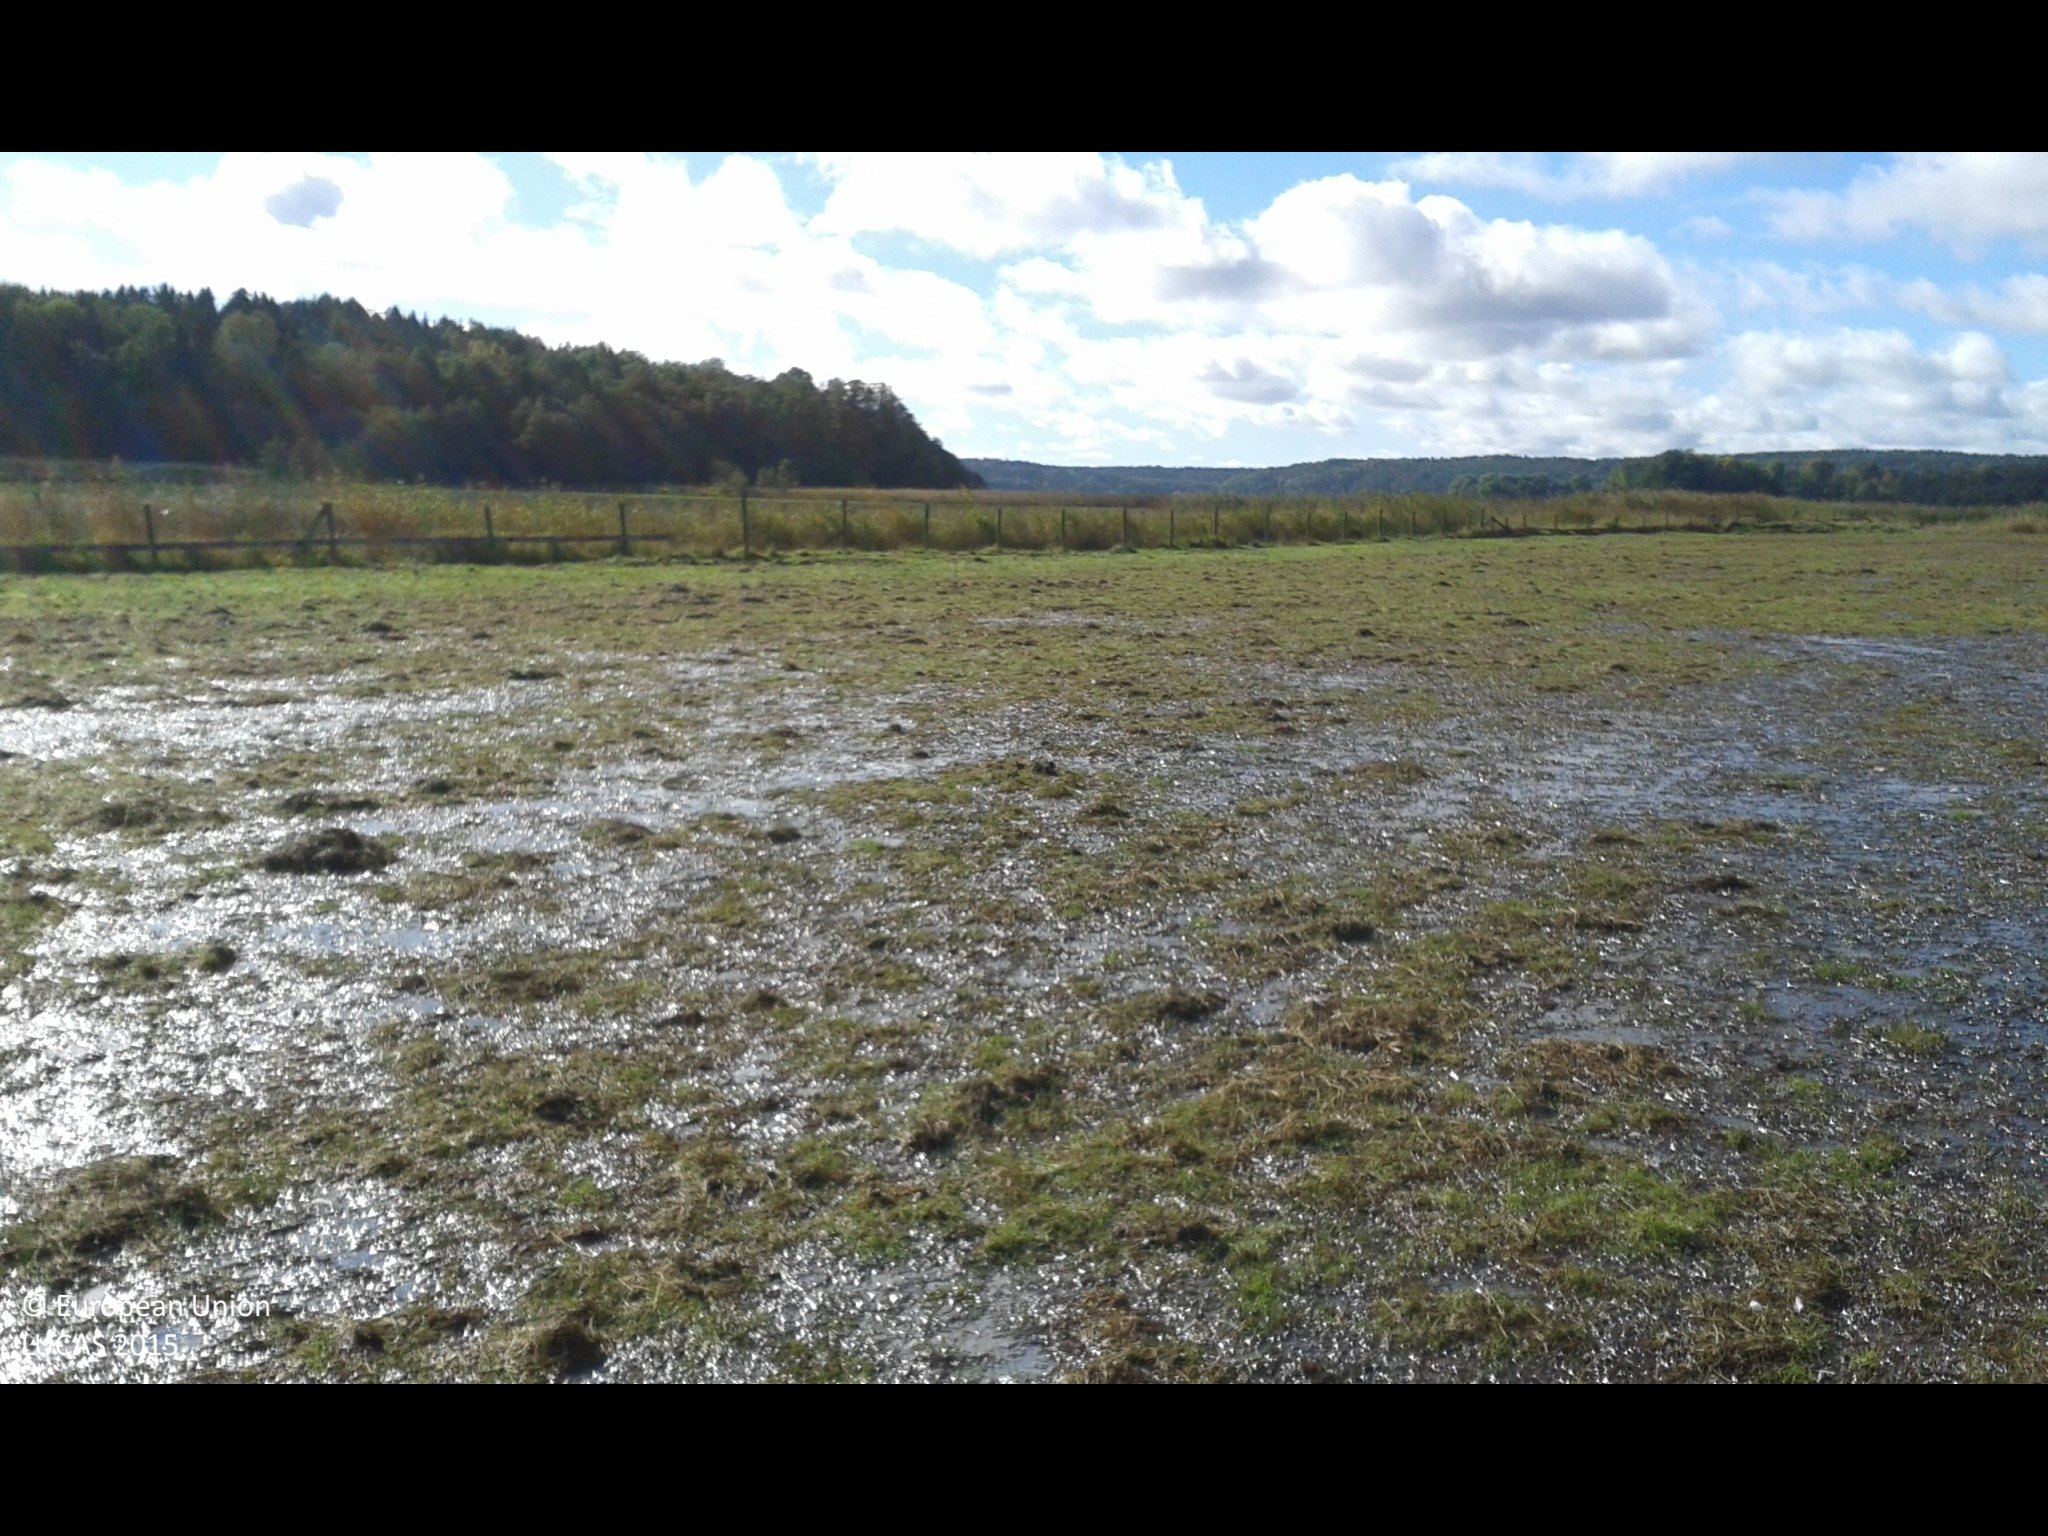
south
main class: Grassland
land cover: Grassland without tree/shrub cover
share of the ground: > 75 %
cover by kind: herbaceous plants 100 %
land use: Agriculture (excluding fallow land and kitchen gardens)
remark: Temporary flooded
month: September
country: SE
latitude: 58.9628
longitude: 17.5969
